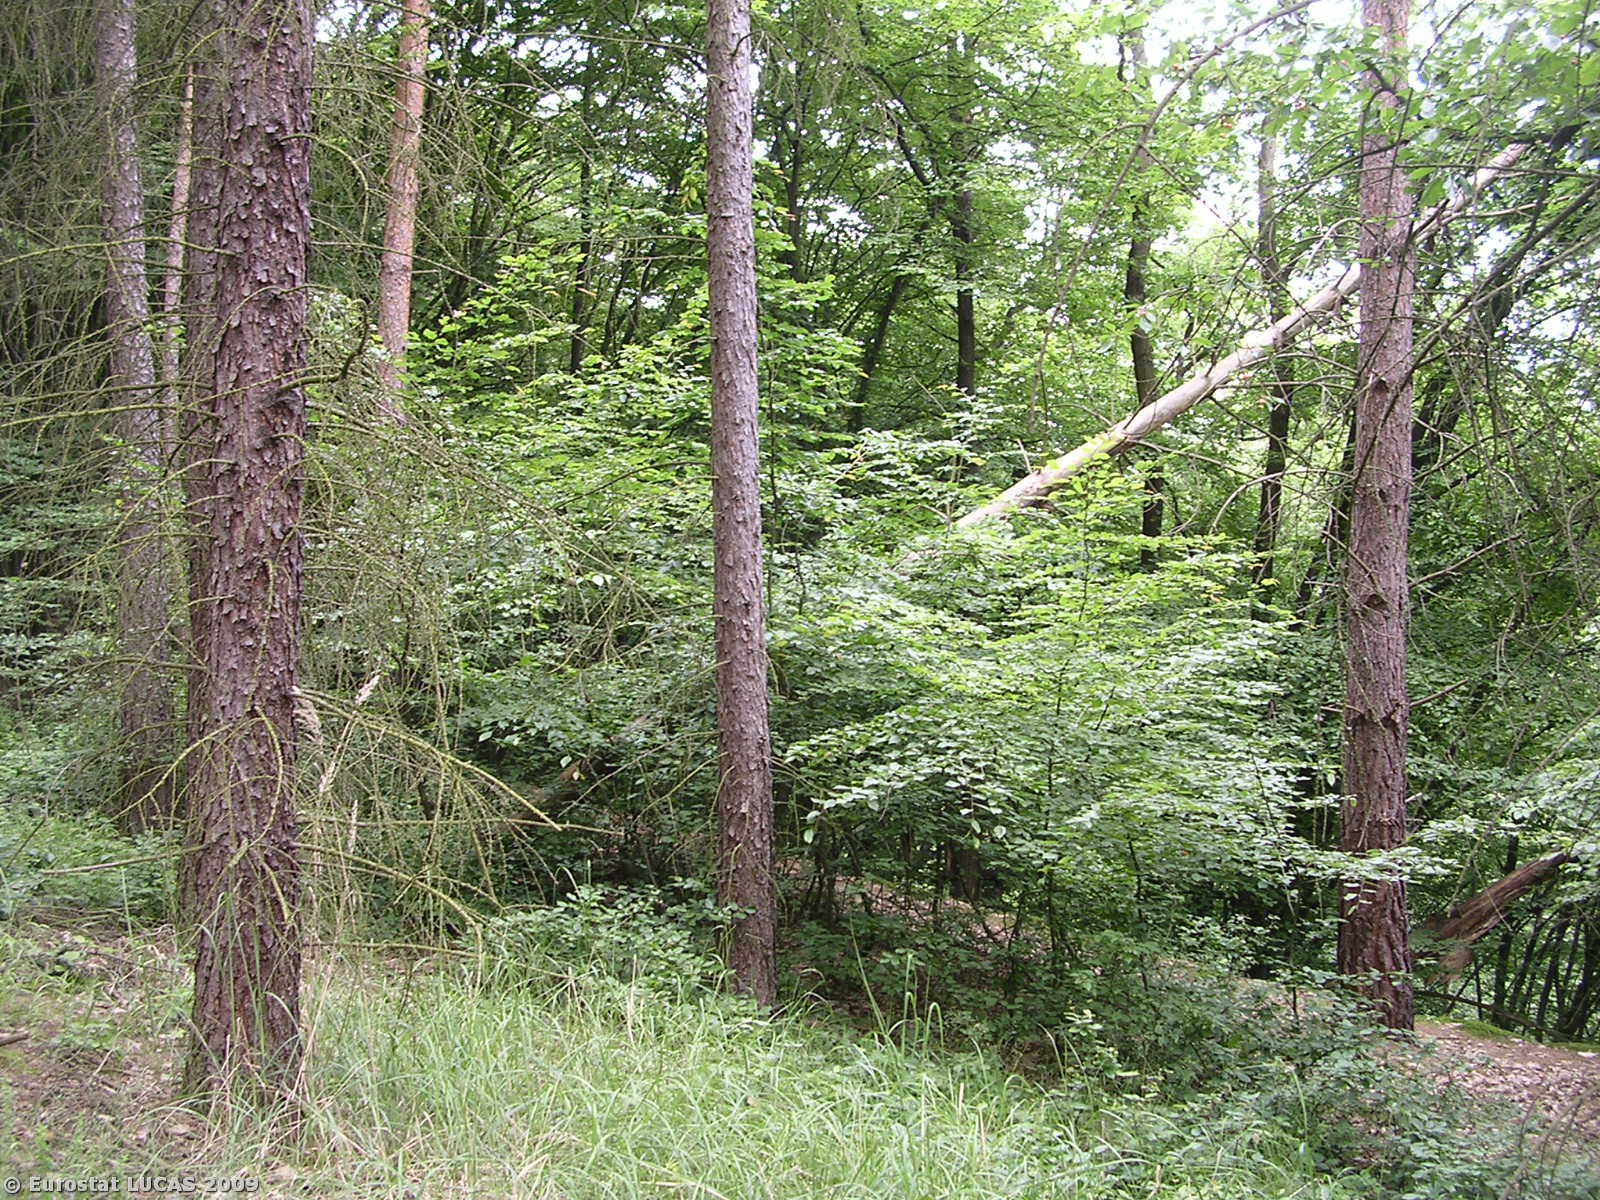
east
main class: Woodland
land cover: Coniferous woodland
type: hemiboreal forest and nemoral coniferous forest and mixed broadleaved-coniferous forest
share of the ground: > 75 %
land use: Forestry
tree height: > 5 m
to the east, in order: Coniferous woodland; Broadleaved woodland; Rock outcrops; Broadleaved woodland
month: June
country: CZ
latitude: 50.4727
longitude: 14.5248
